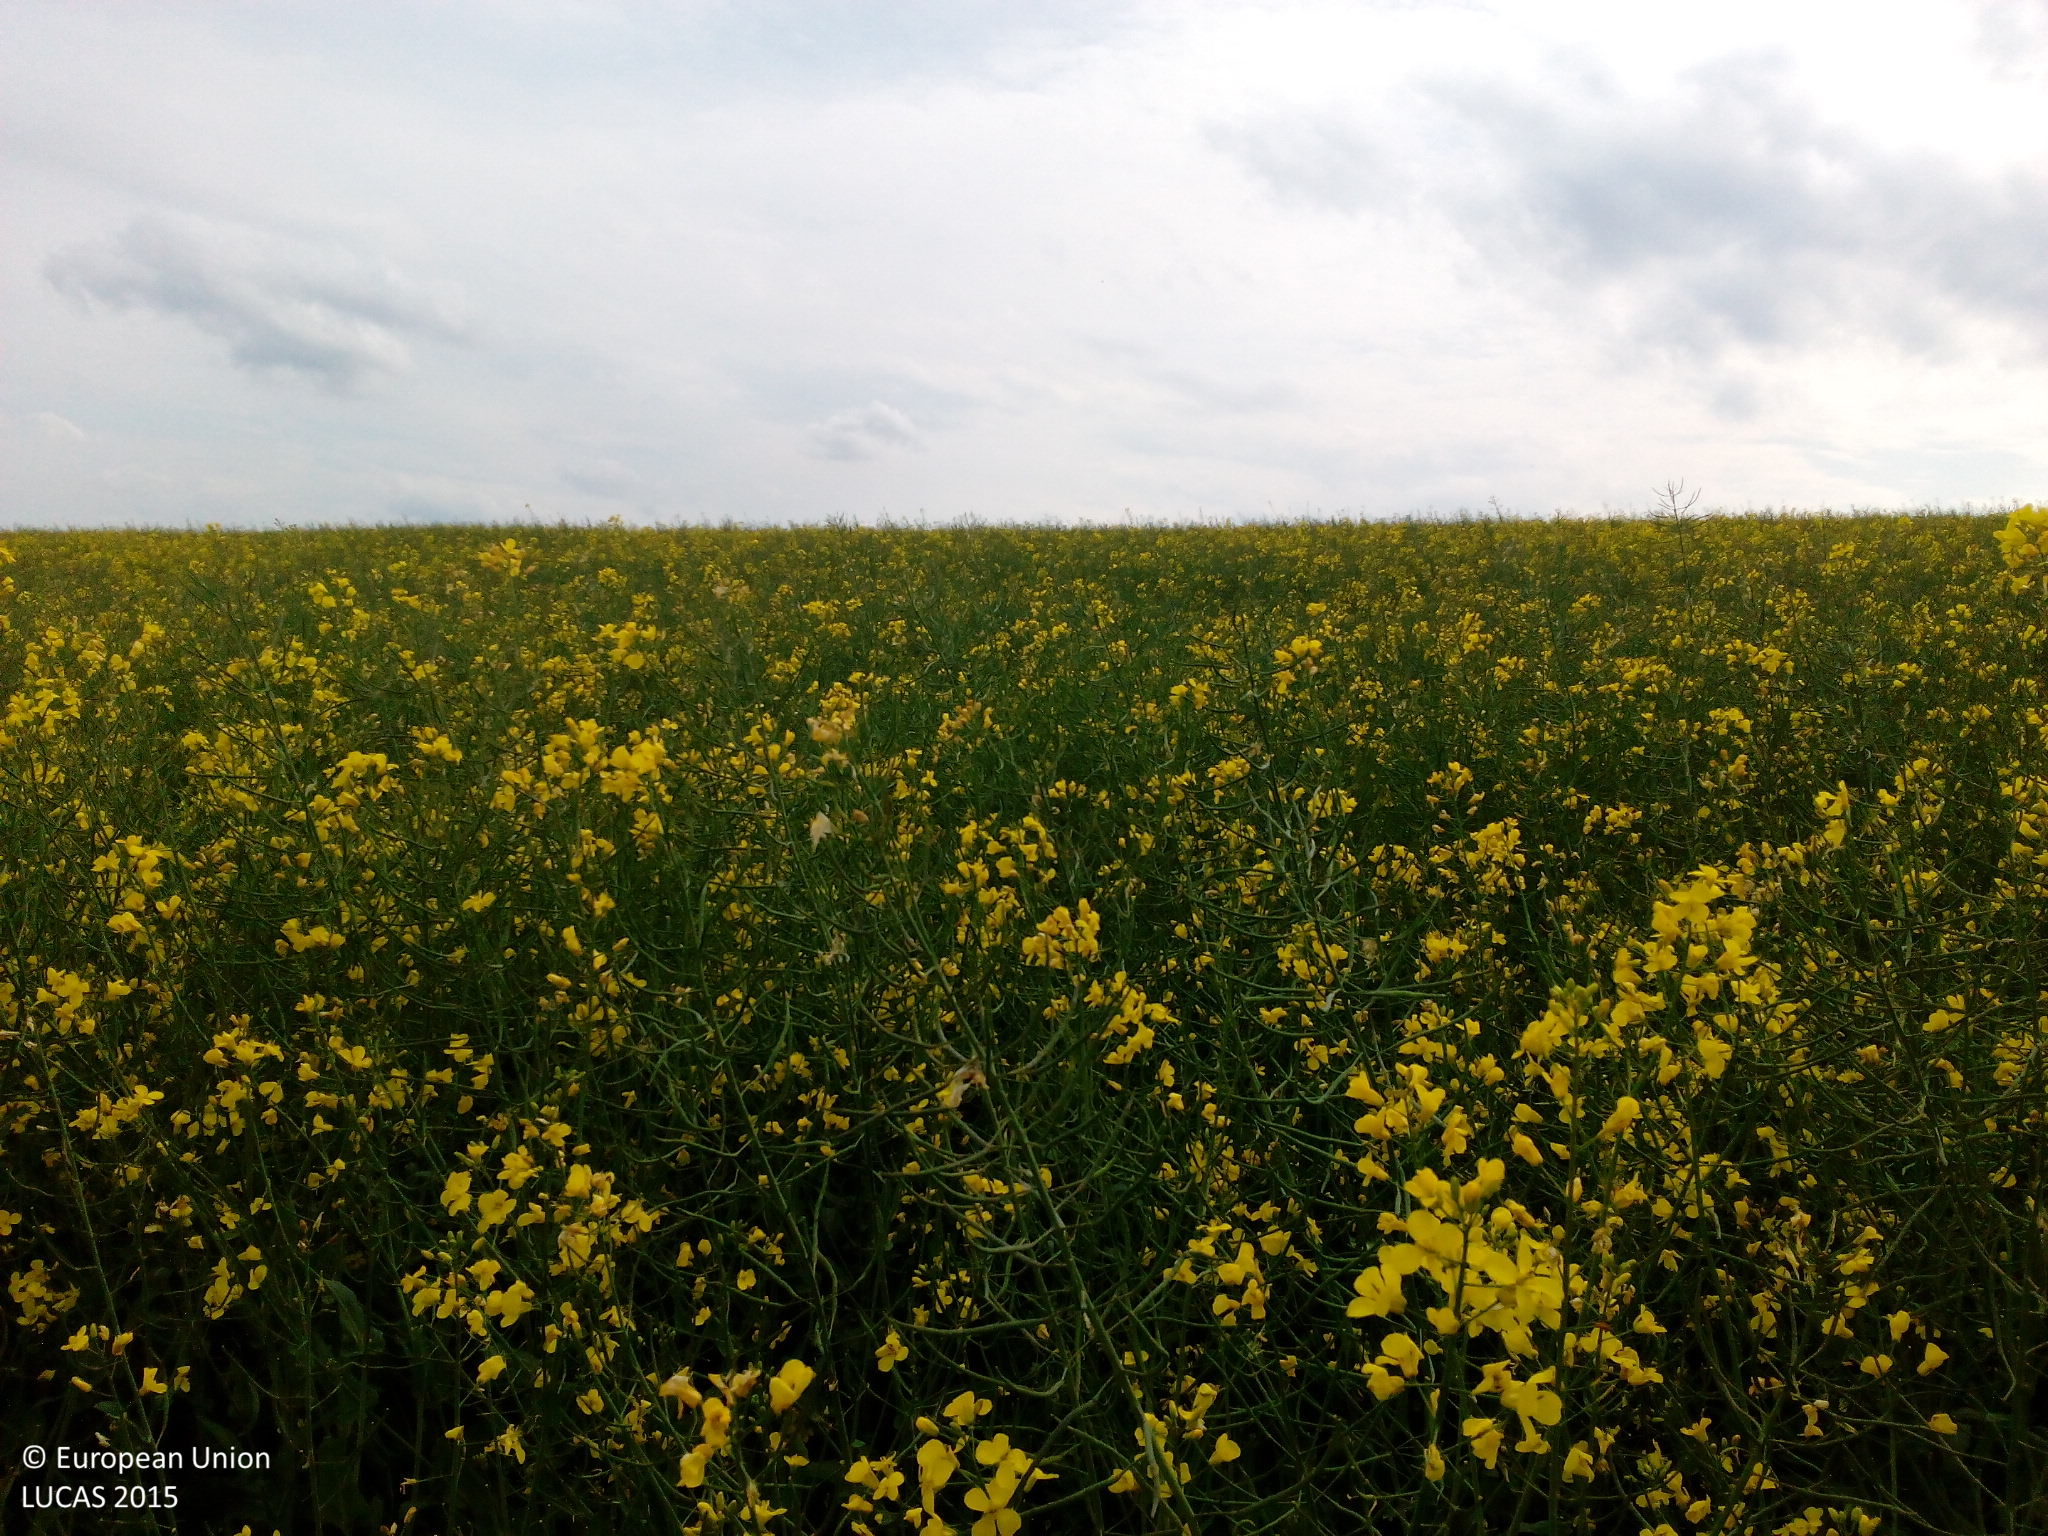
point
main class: Cropland
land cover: Rape and turnip rape
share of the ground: > 75 %
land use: Agriculture (excluding fallow land and kitchen gardens)
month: May
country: DE
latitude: 49.7594
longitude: 11.5960
